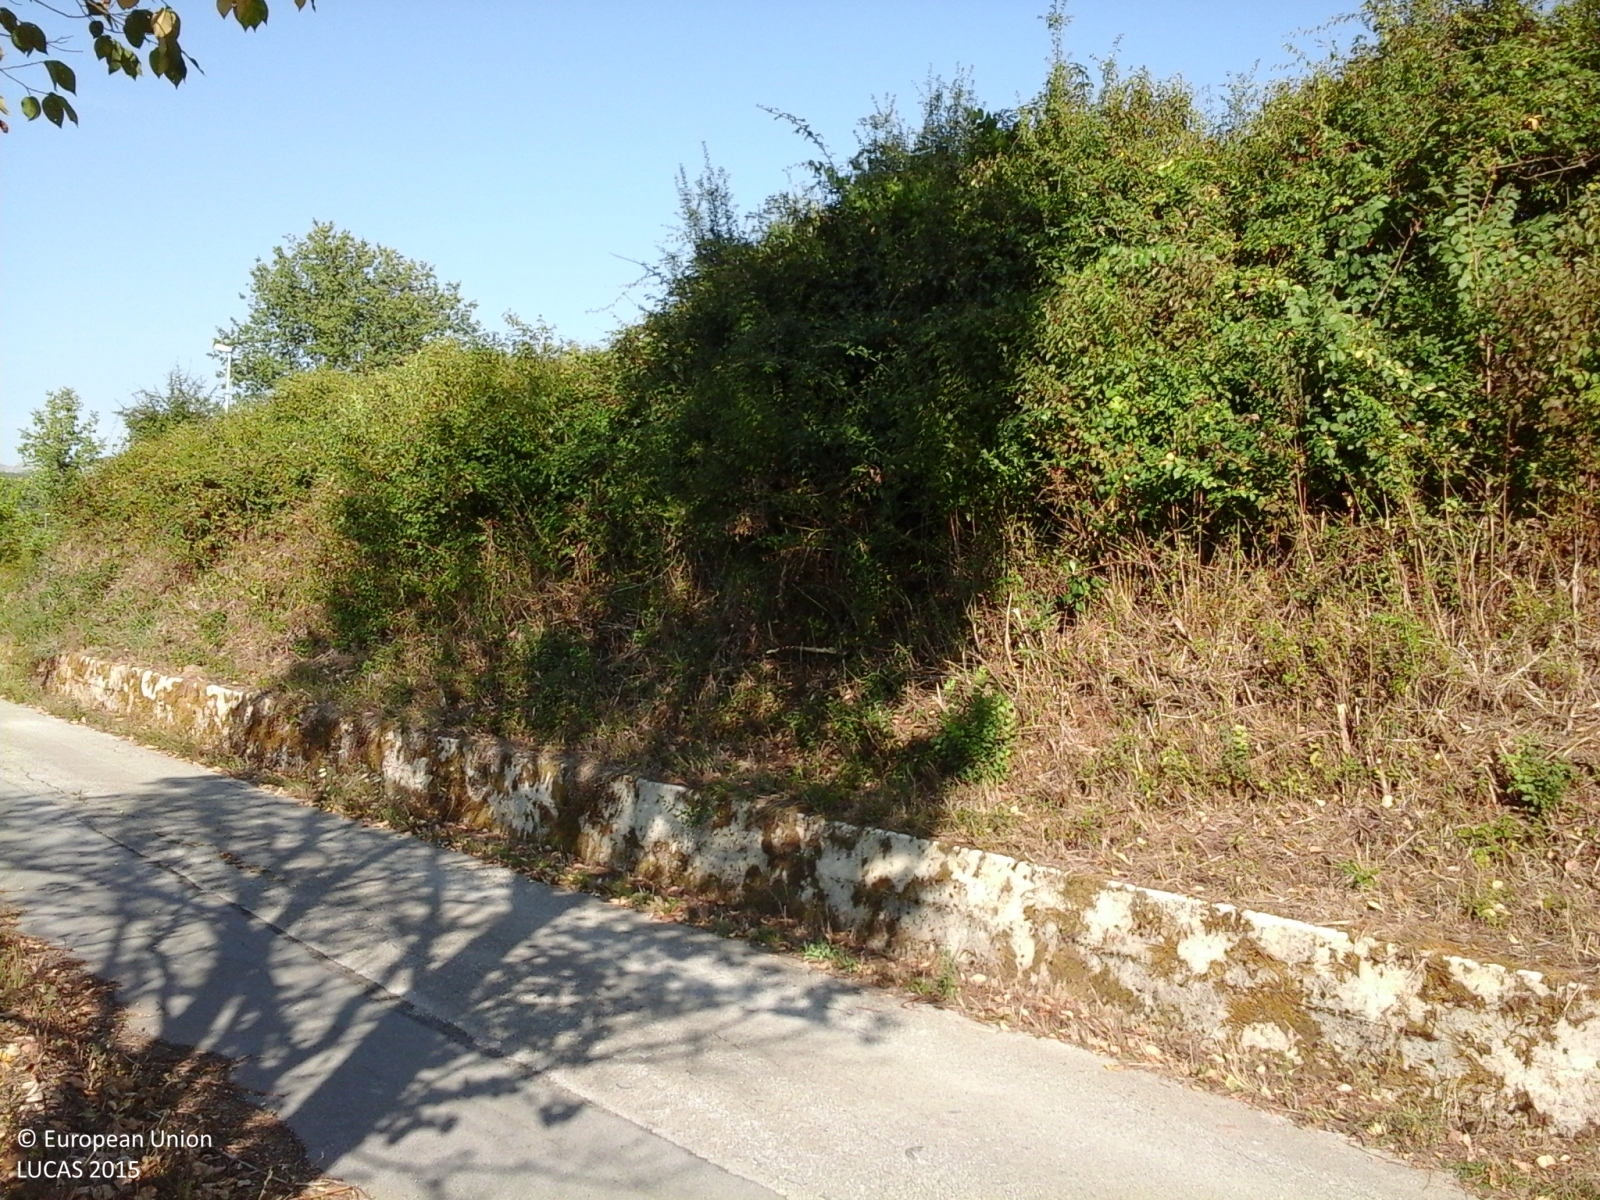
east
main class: Woodland
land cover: Broadleaved woodland
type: thermophilous deciduous forest
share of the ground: > 75 %
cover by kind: broadleaved forest trees 85 %, shrubs 10 %, herbaceous plants 5 %
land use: Semi-natural and natural areas not in use
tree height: > 5 m
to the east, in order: Broadleaved woodland; Paved roads, cycling and walking lanes; Abandoned hedges; Spontaneously vegetated surfaces; Abandoned hedges; Fences; Vineyards; Artificial constructions in urban areas; Olive groves; Fences; Shrubland without tree cover; Spontaneously vegetated surfaces
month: September
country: IT
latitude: 41.5732
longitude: 14.1705
